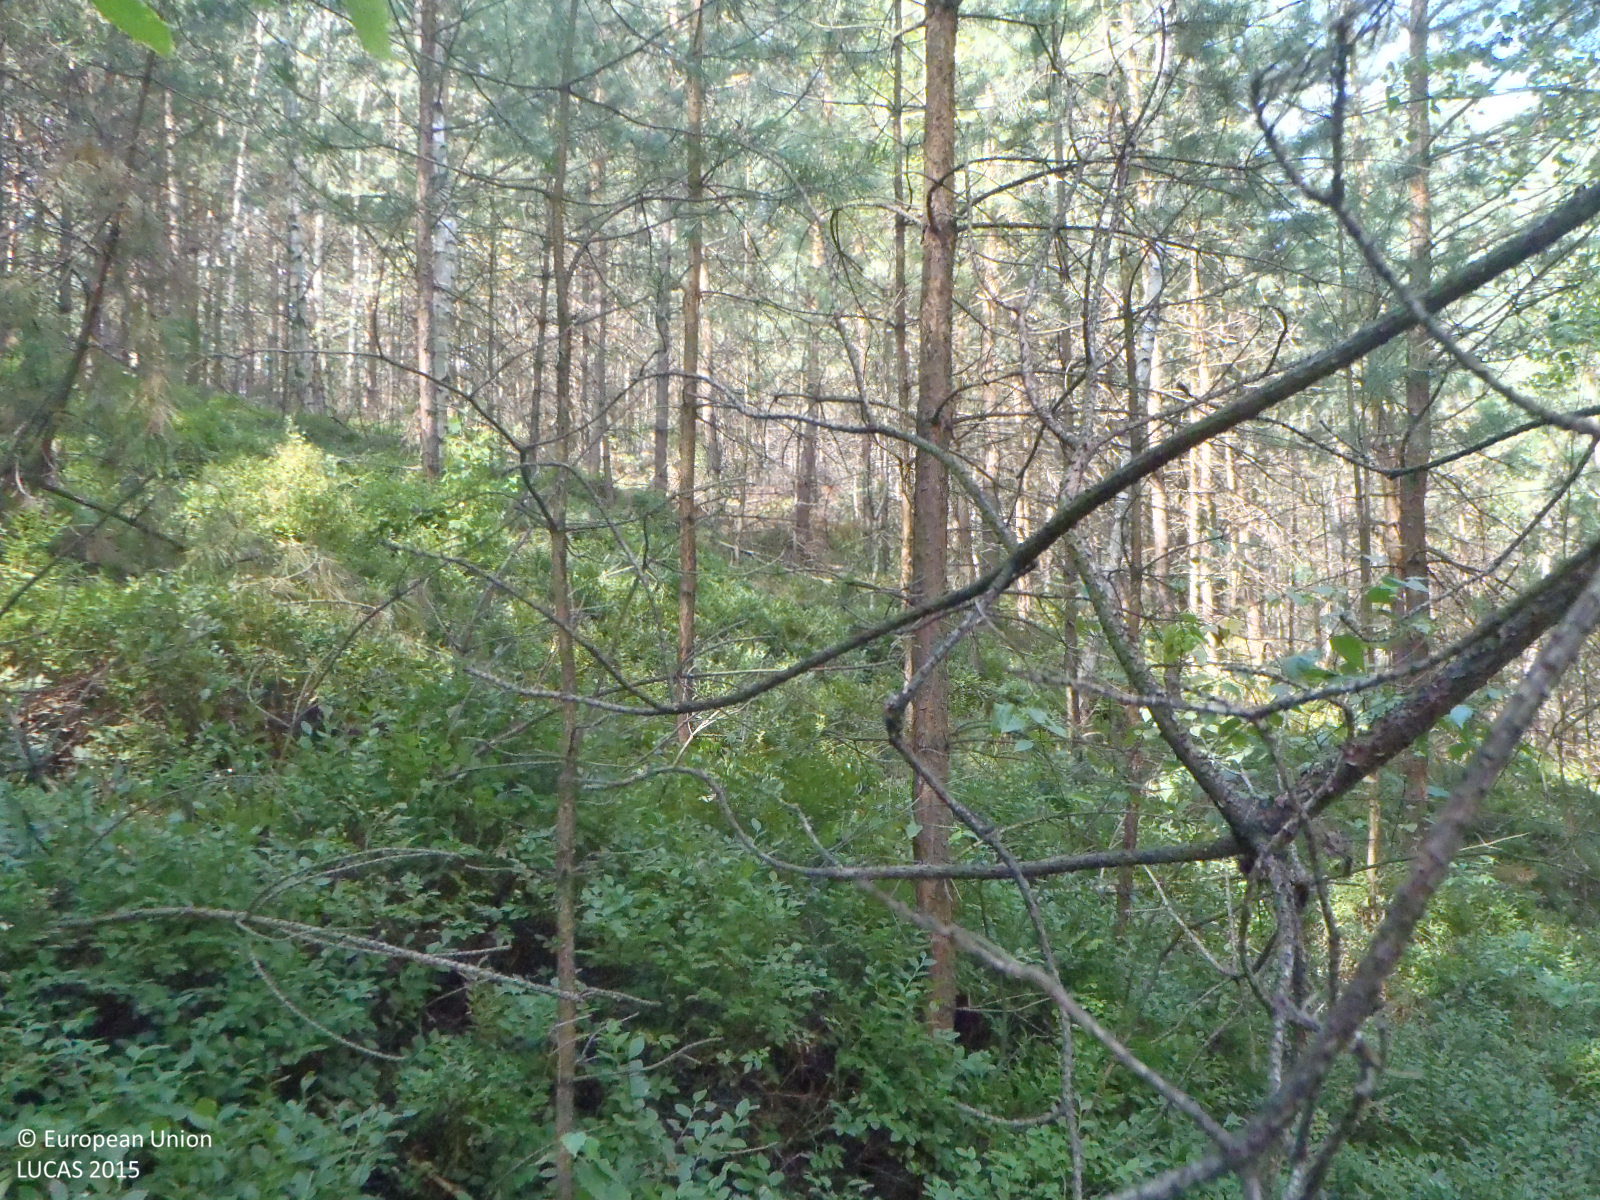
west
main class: Woodland
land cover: Pine dominated coniferous woodland
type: hemiboreal forest and nemoral coniferous forest and mixed broadleaved-coniferous forest
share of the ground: > 75 %
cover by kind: coniferous forest trees 85 %, broadleaved forest trees 10 %, herbaceous plants 5 %
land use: Forestry
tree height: > 5 m
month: August
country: CZ
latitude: 50.6510
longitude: 14.5703
